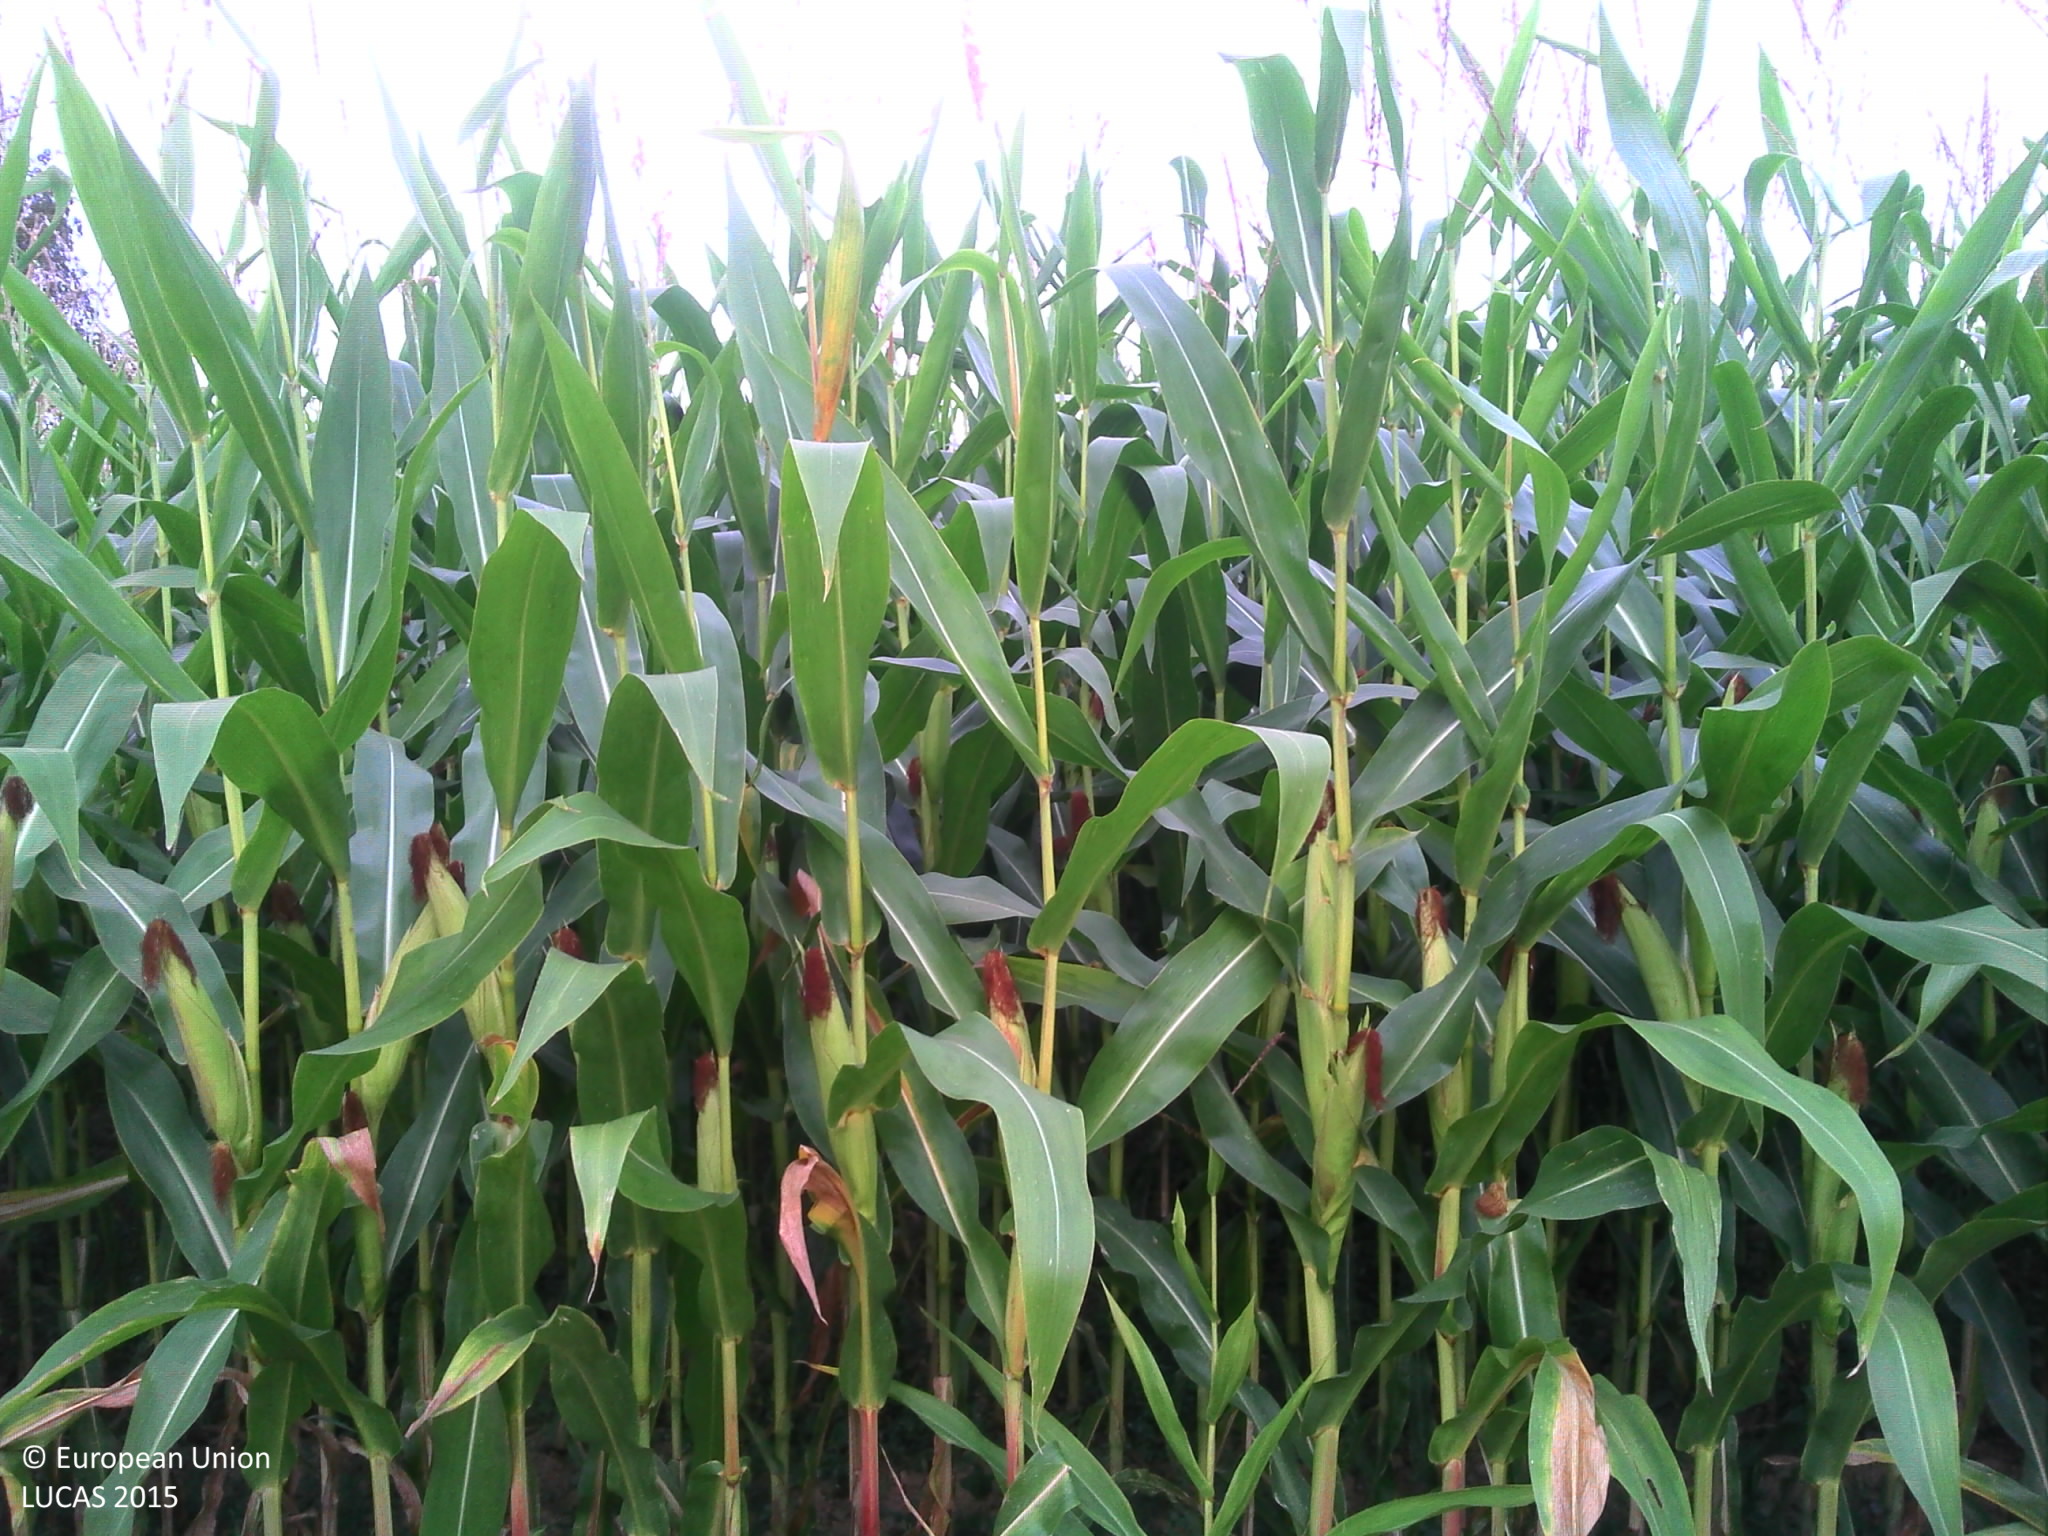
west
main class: Cropland
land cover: Maize
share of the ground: > 75 %
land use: Agriculture (excluding fallow land and kitchen gardens)
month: August
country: FR
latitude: 48.7926
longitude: 2.9536
